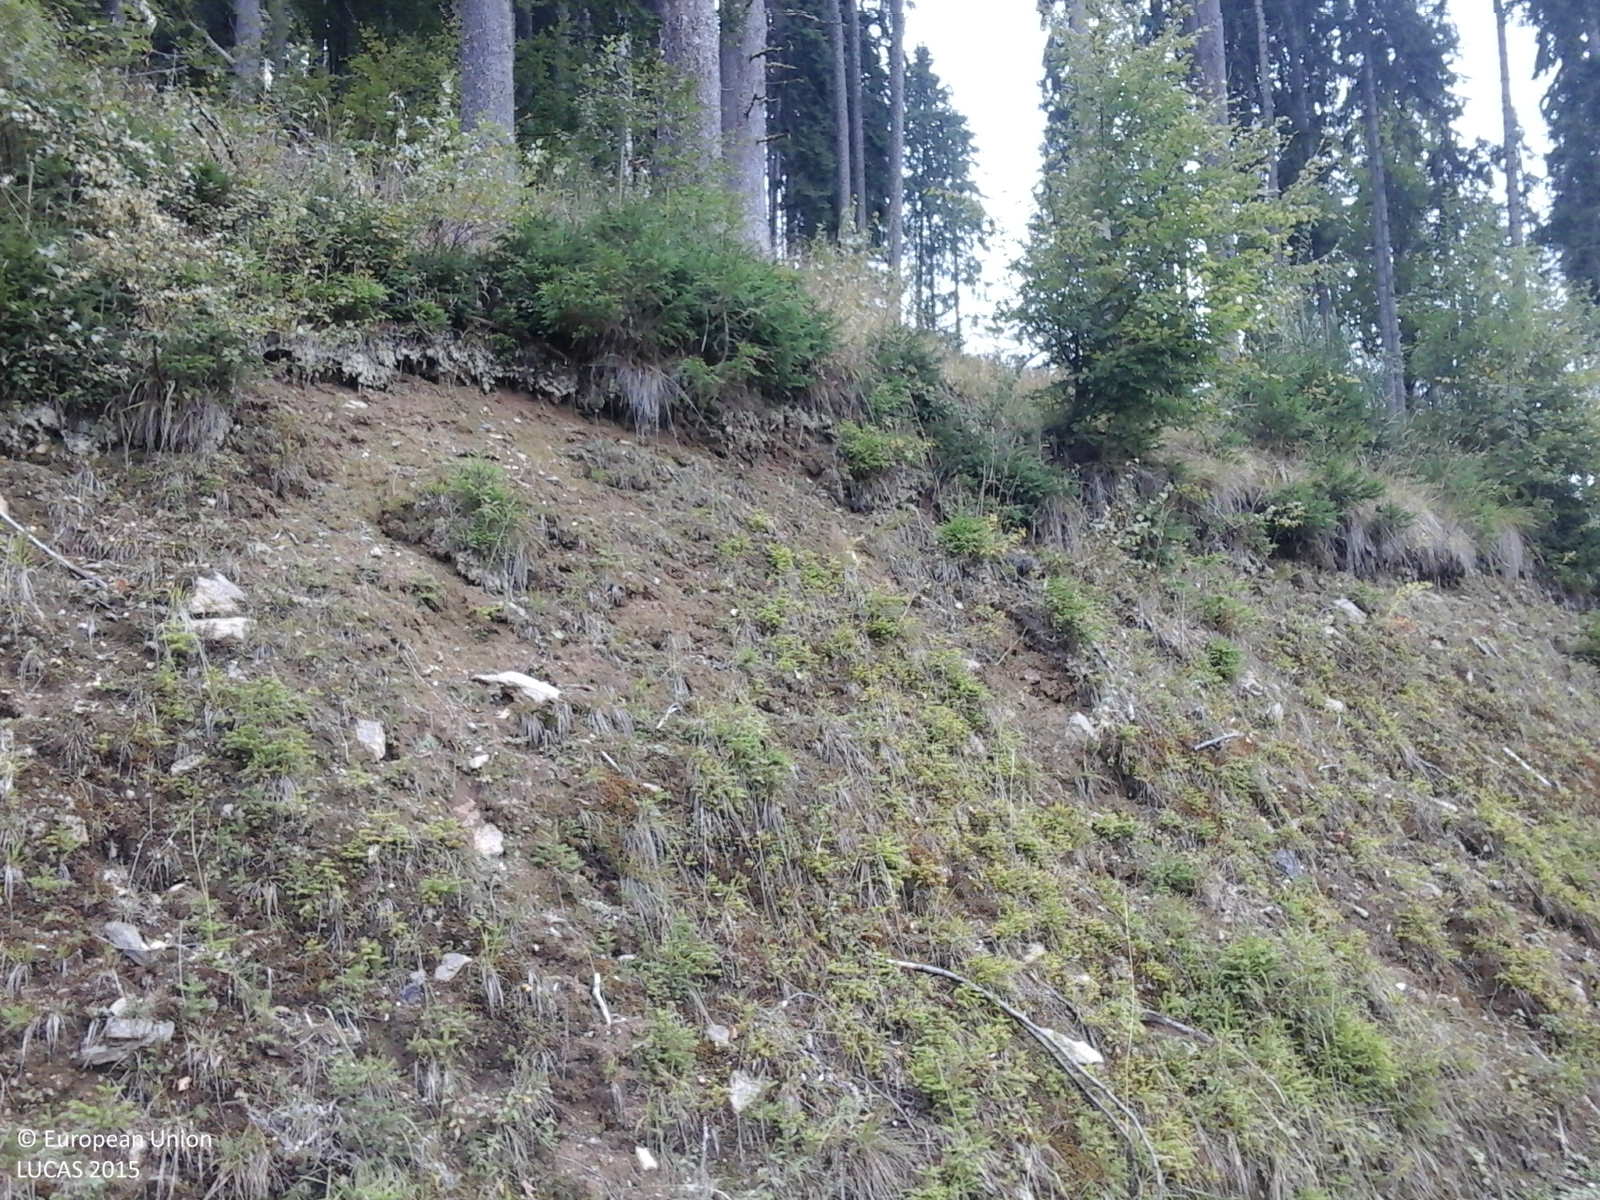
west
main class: Grassland
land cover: Spontaneously vegetated surfaces
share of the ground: > 75 %
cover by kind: herbaceous plants 100 %
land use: Forestry
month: September
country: RO
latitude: 45.6709
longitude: 23.6589
